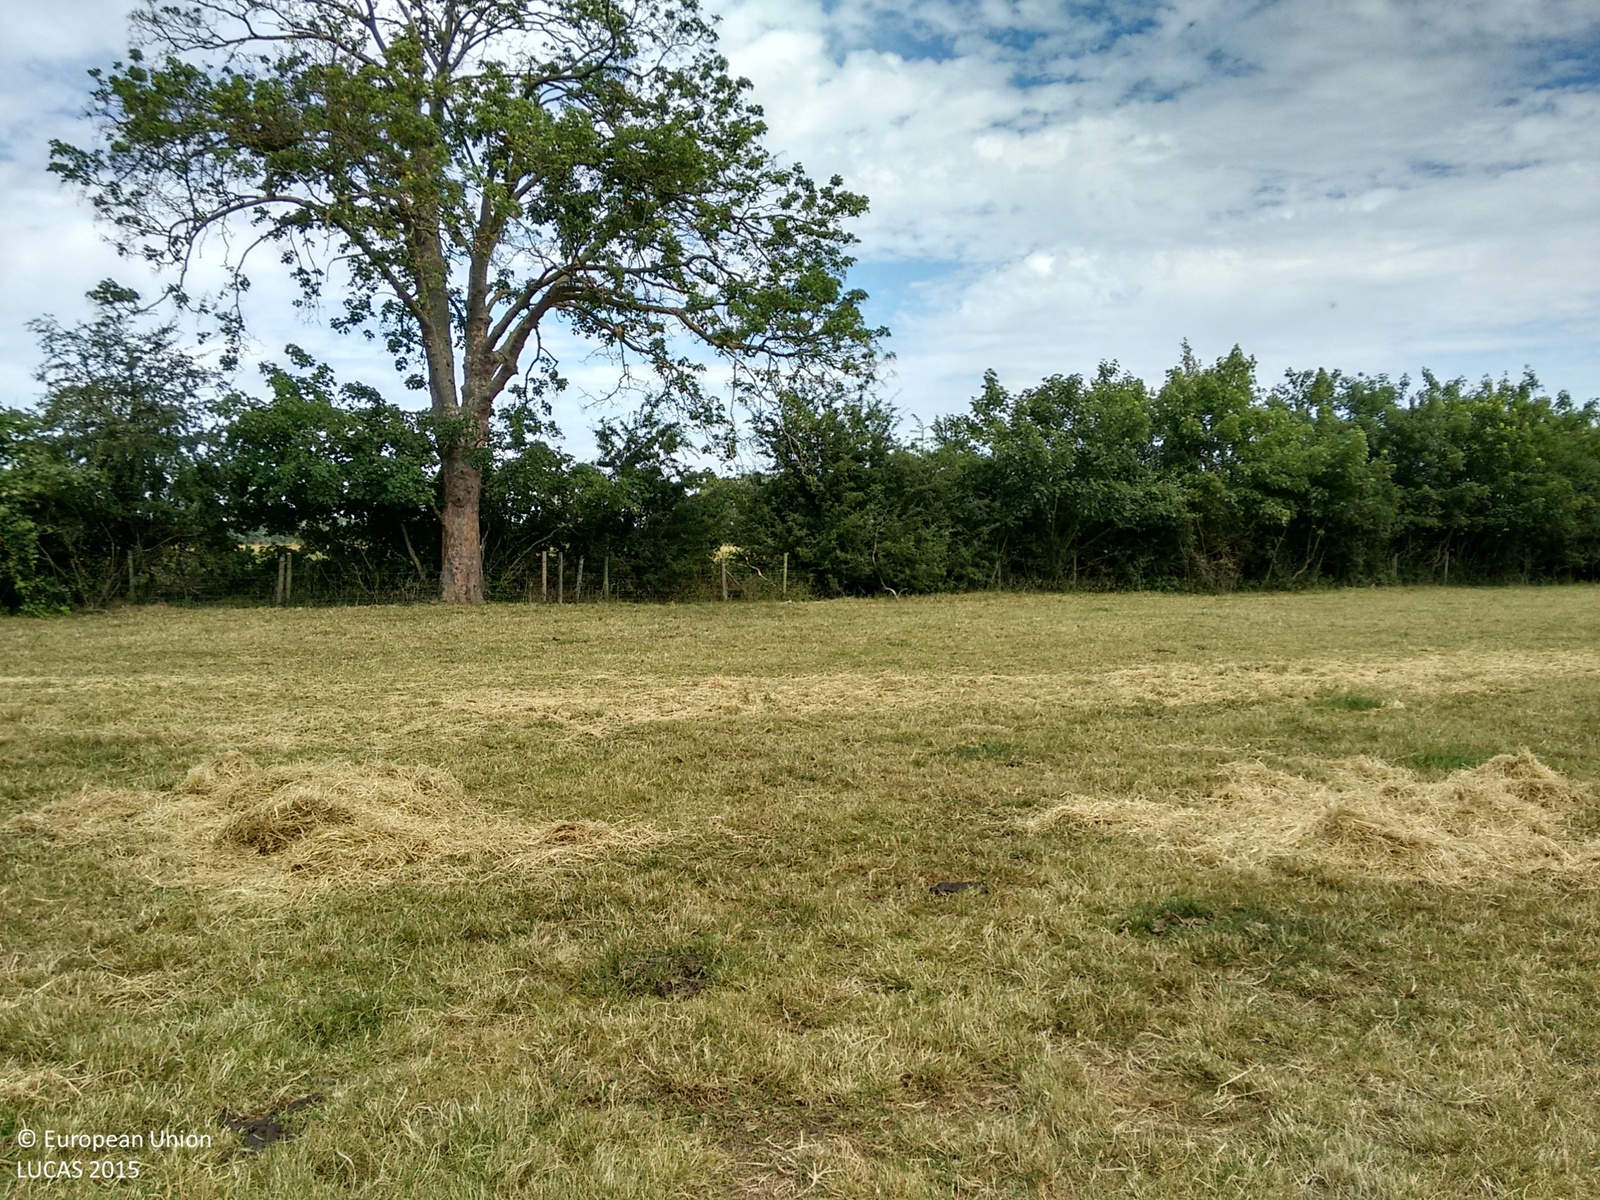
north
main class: Grassland
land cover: Grassland without tree/shrub cover
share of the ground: > 75 %
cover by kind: herbaceous plants 100 %
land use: Agriculture (excluding fallow land and kitchen gardens)
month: July
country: GB
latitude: 51.6441
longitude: -1.2181
